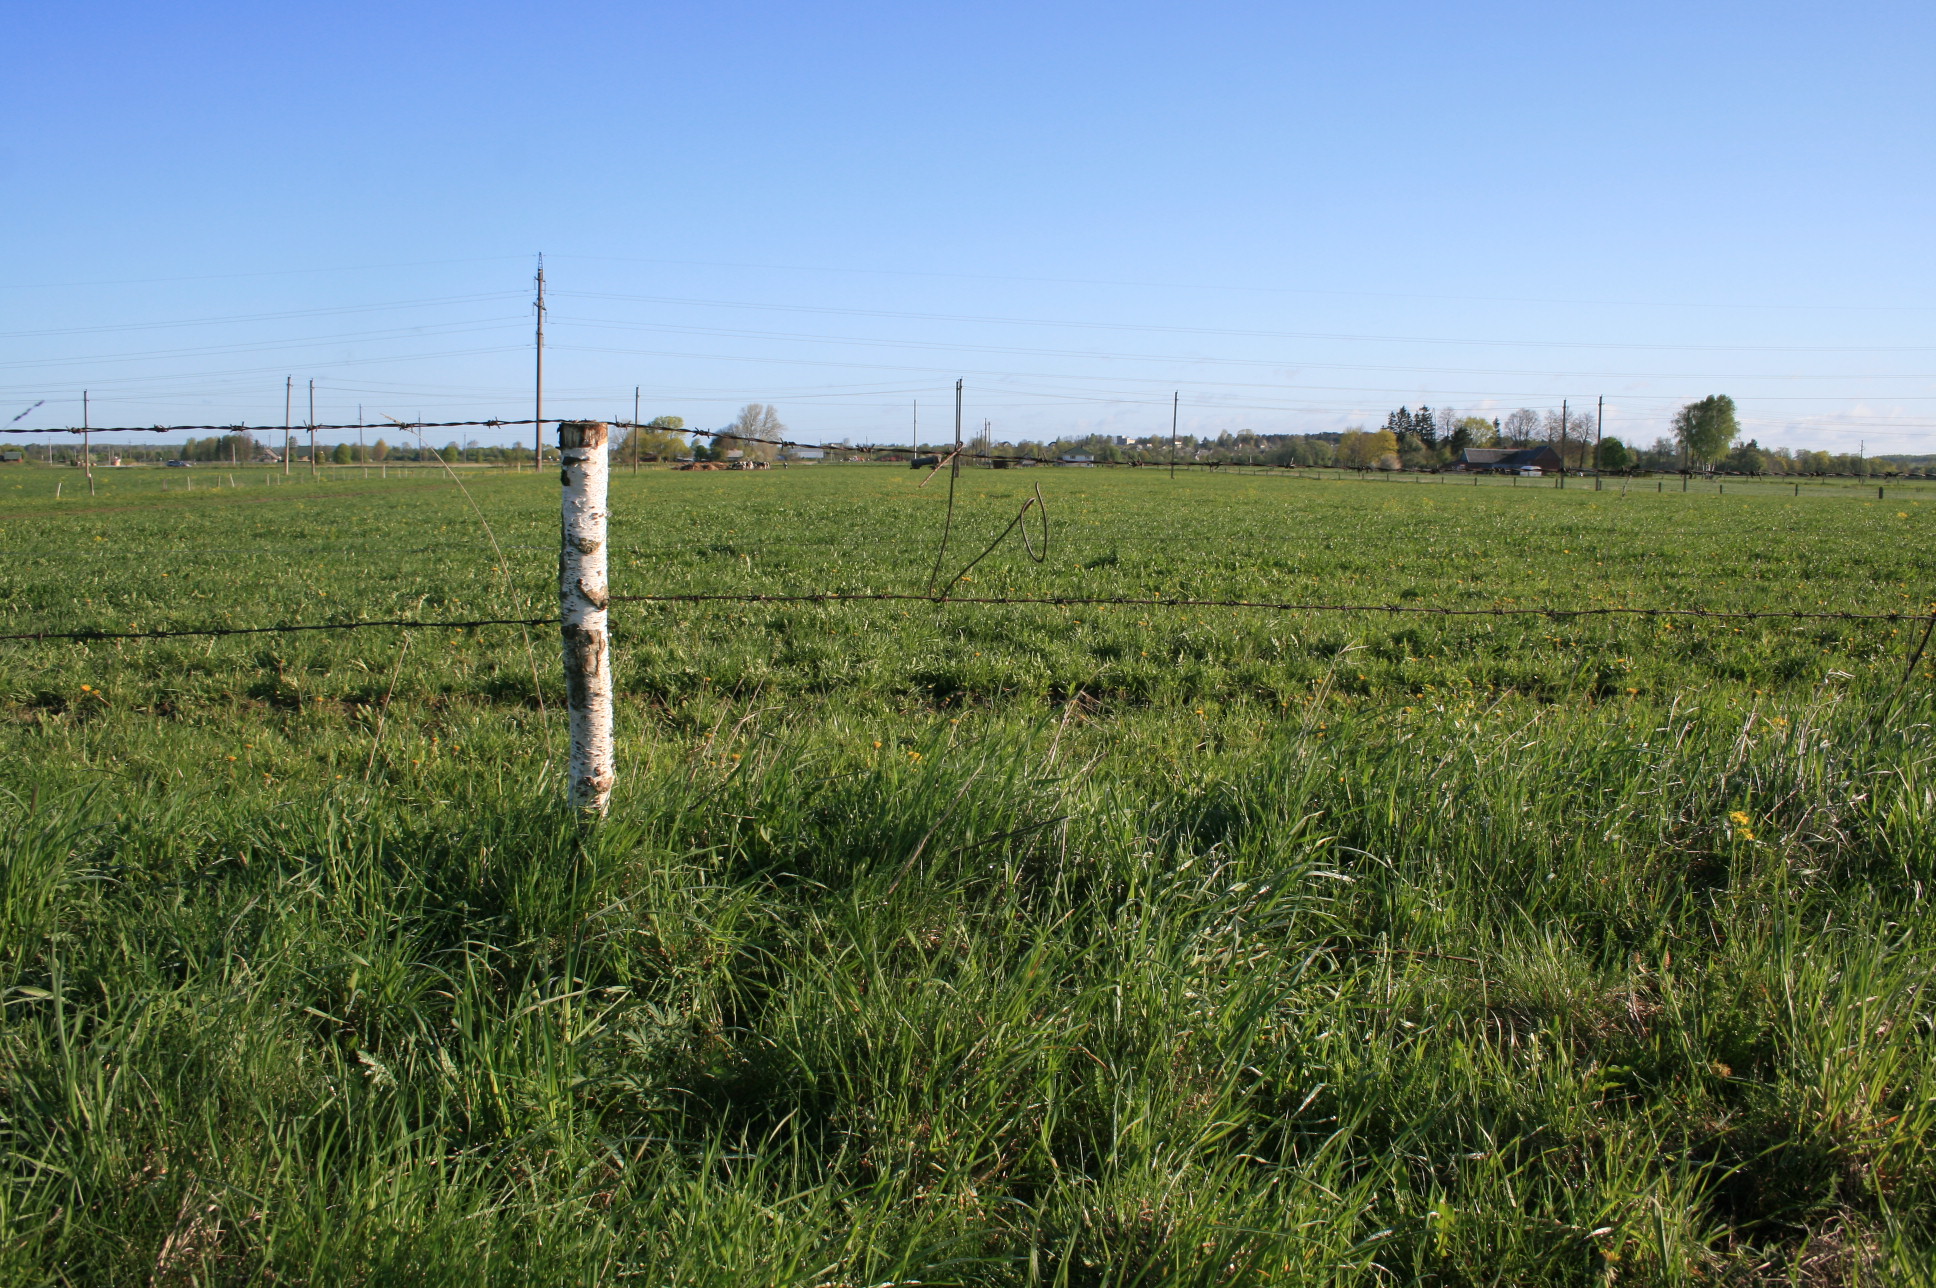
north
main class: Grassland
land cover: Grassland without tree/shrub cover
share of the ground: > 75 %
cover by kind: herbaceous plants 100 %
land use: Agriculture (excluding fallow land and kitchen gardens)
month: May
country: LT
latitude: 56.2638
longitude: 21.5553
